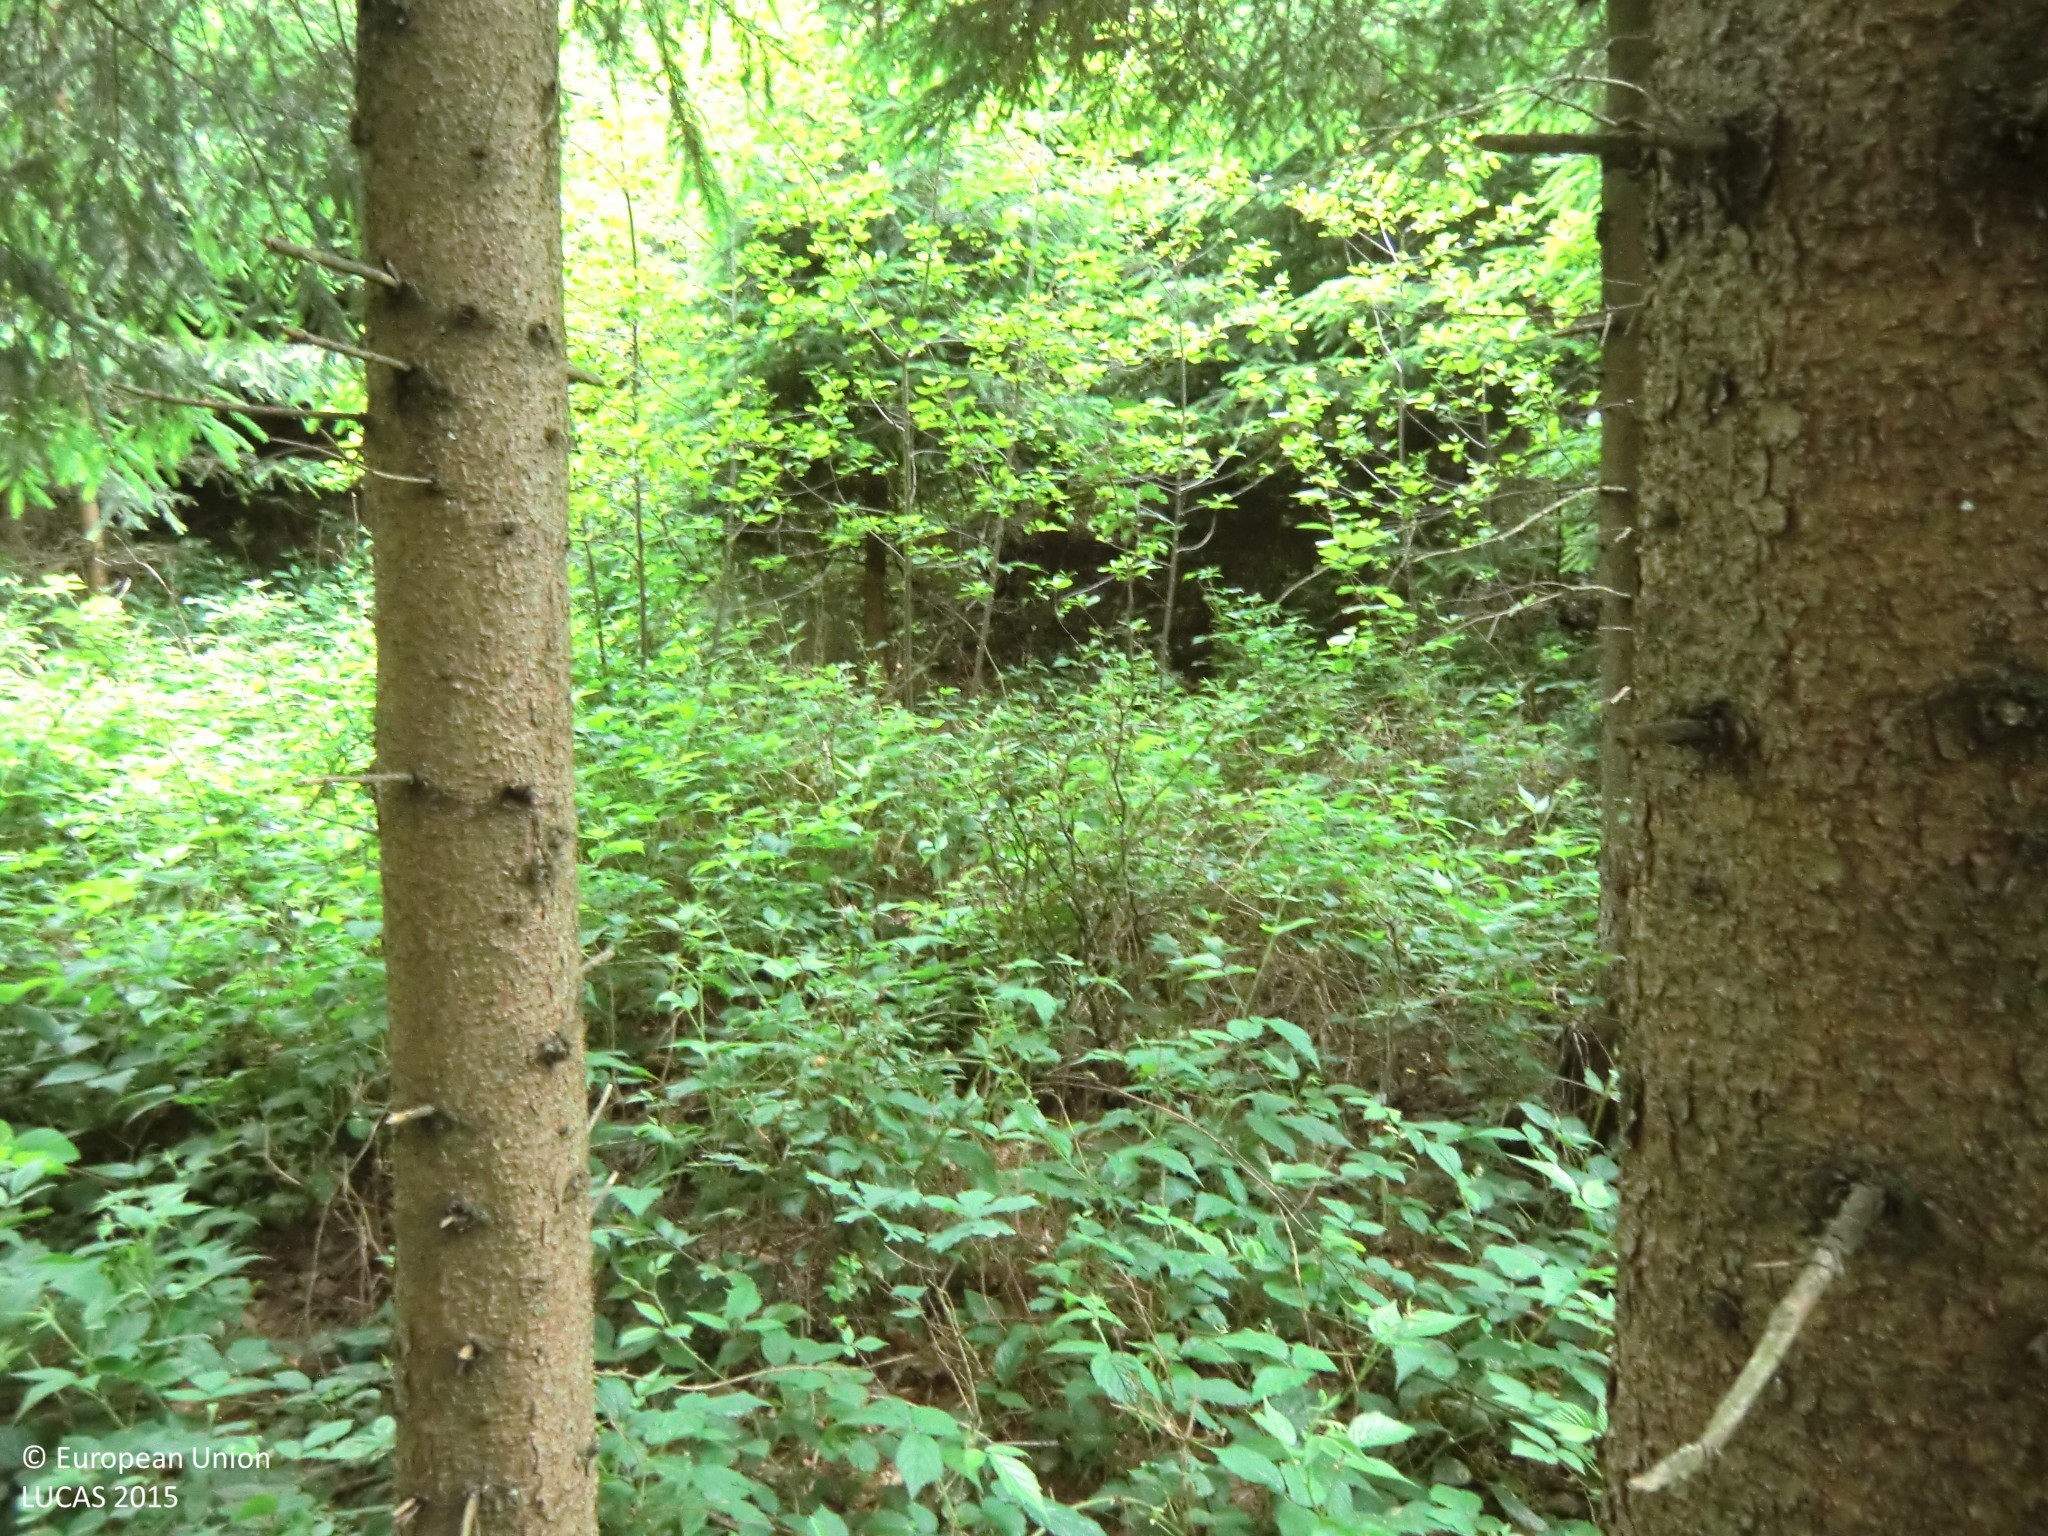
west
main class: Woodland
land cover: Spruce dominated coniferous woodland
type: hemiboreal forest and nemoral coniferous forest and mixed broadleaved-coniferous forest
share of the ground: > 75 %
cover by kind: coniferous forest trees 90 %, unconsolidated bare surface 10 %
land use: Forestry
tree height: > 5 m
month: June
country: AT
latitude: 48.2700
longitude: 15.0537
